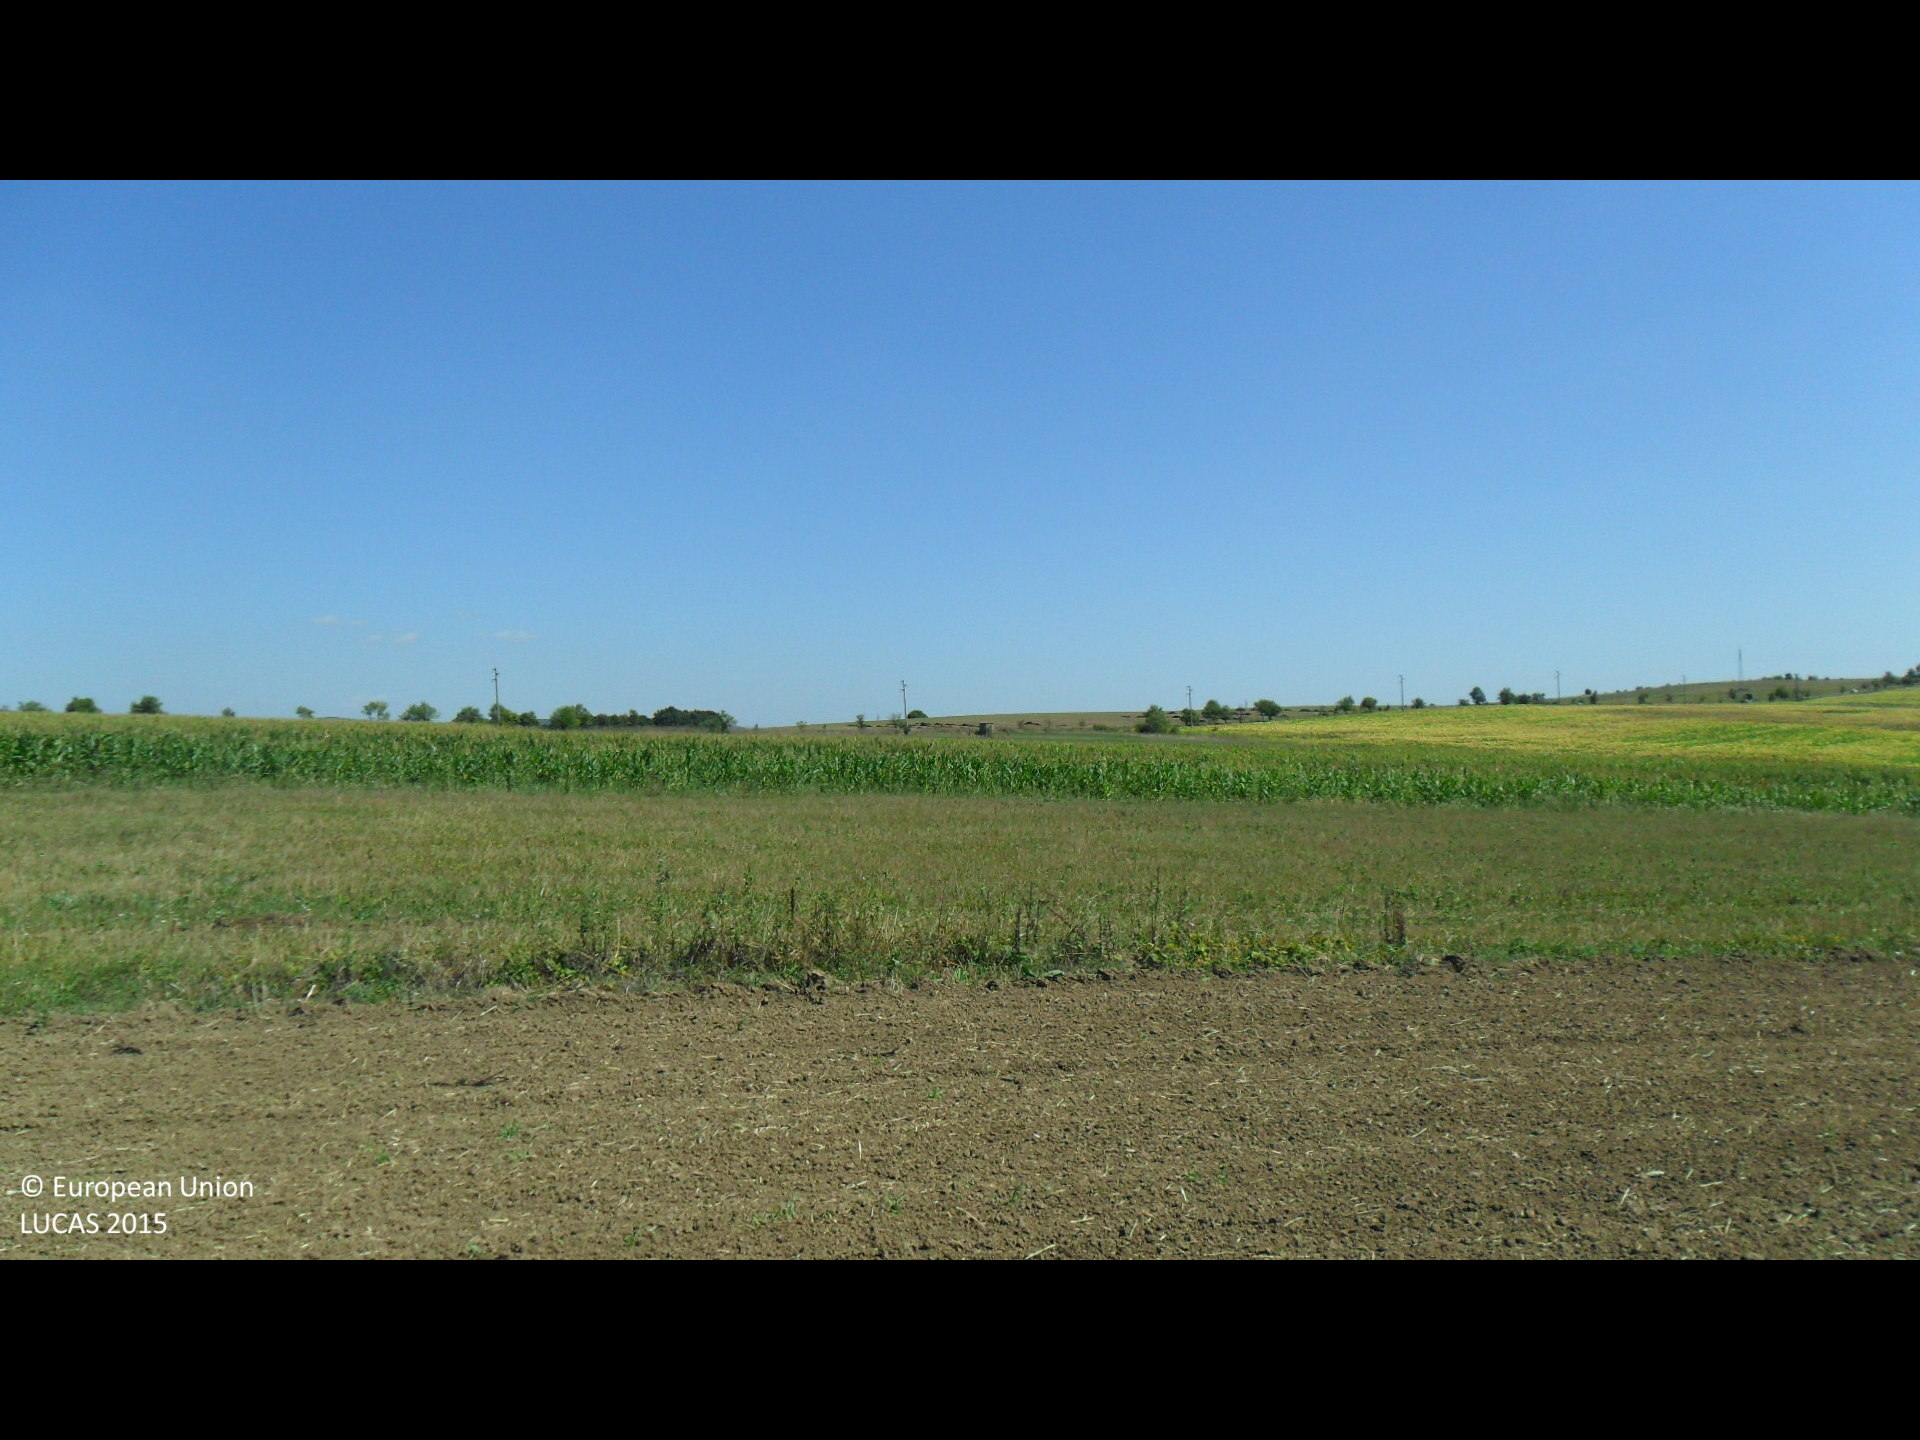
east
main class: Cropland
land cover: Common wheat
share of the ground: < 10 %
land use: Agriculture (excluding fallow land and kitchen gardens)
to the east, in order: Common wheat; Grassland without tree/shrub cover; Maize; Lucerne
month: September
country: BG
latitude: 43.1741
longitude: 26.4482
